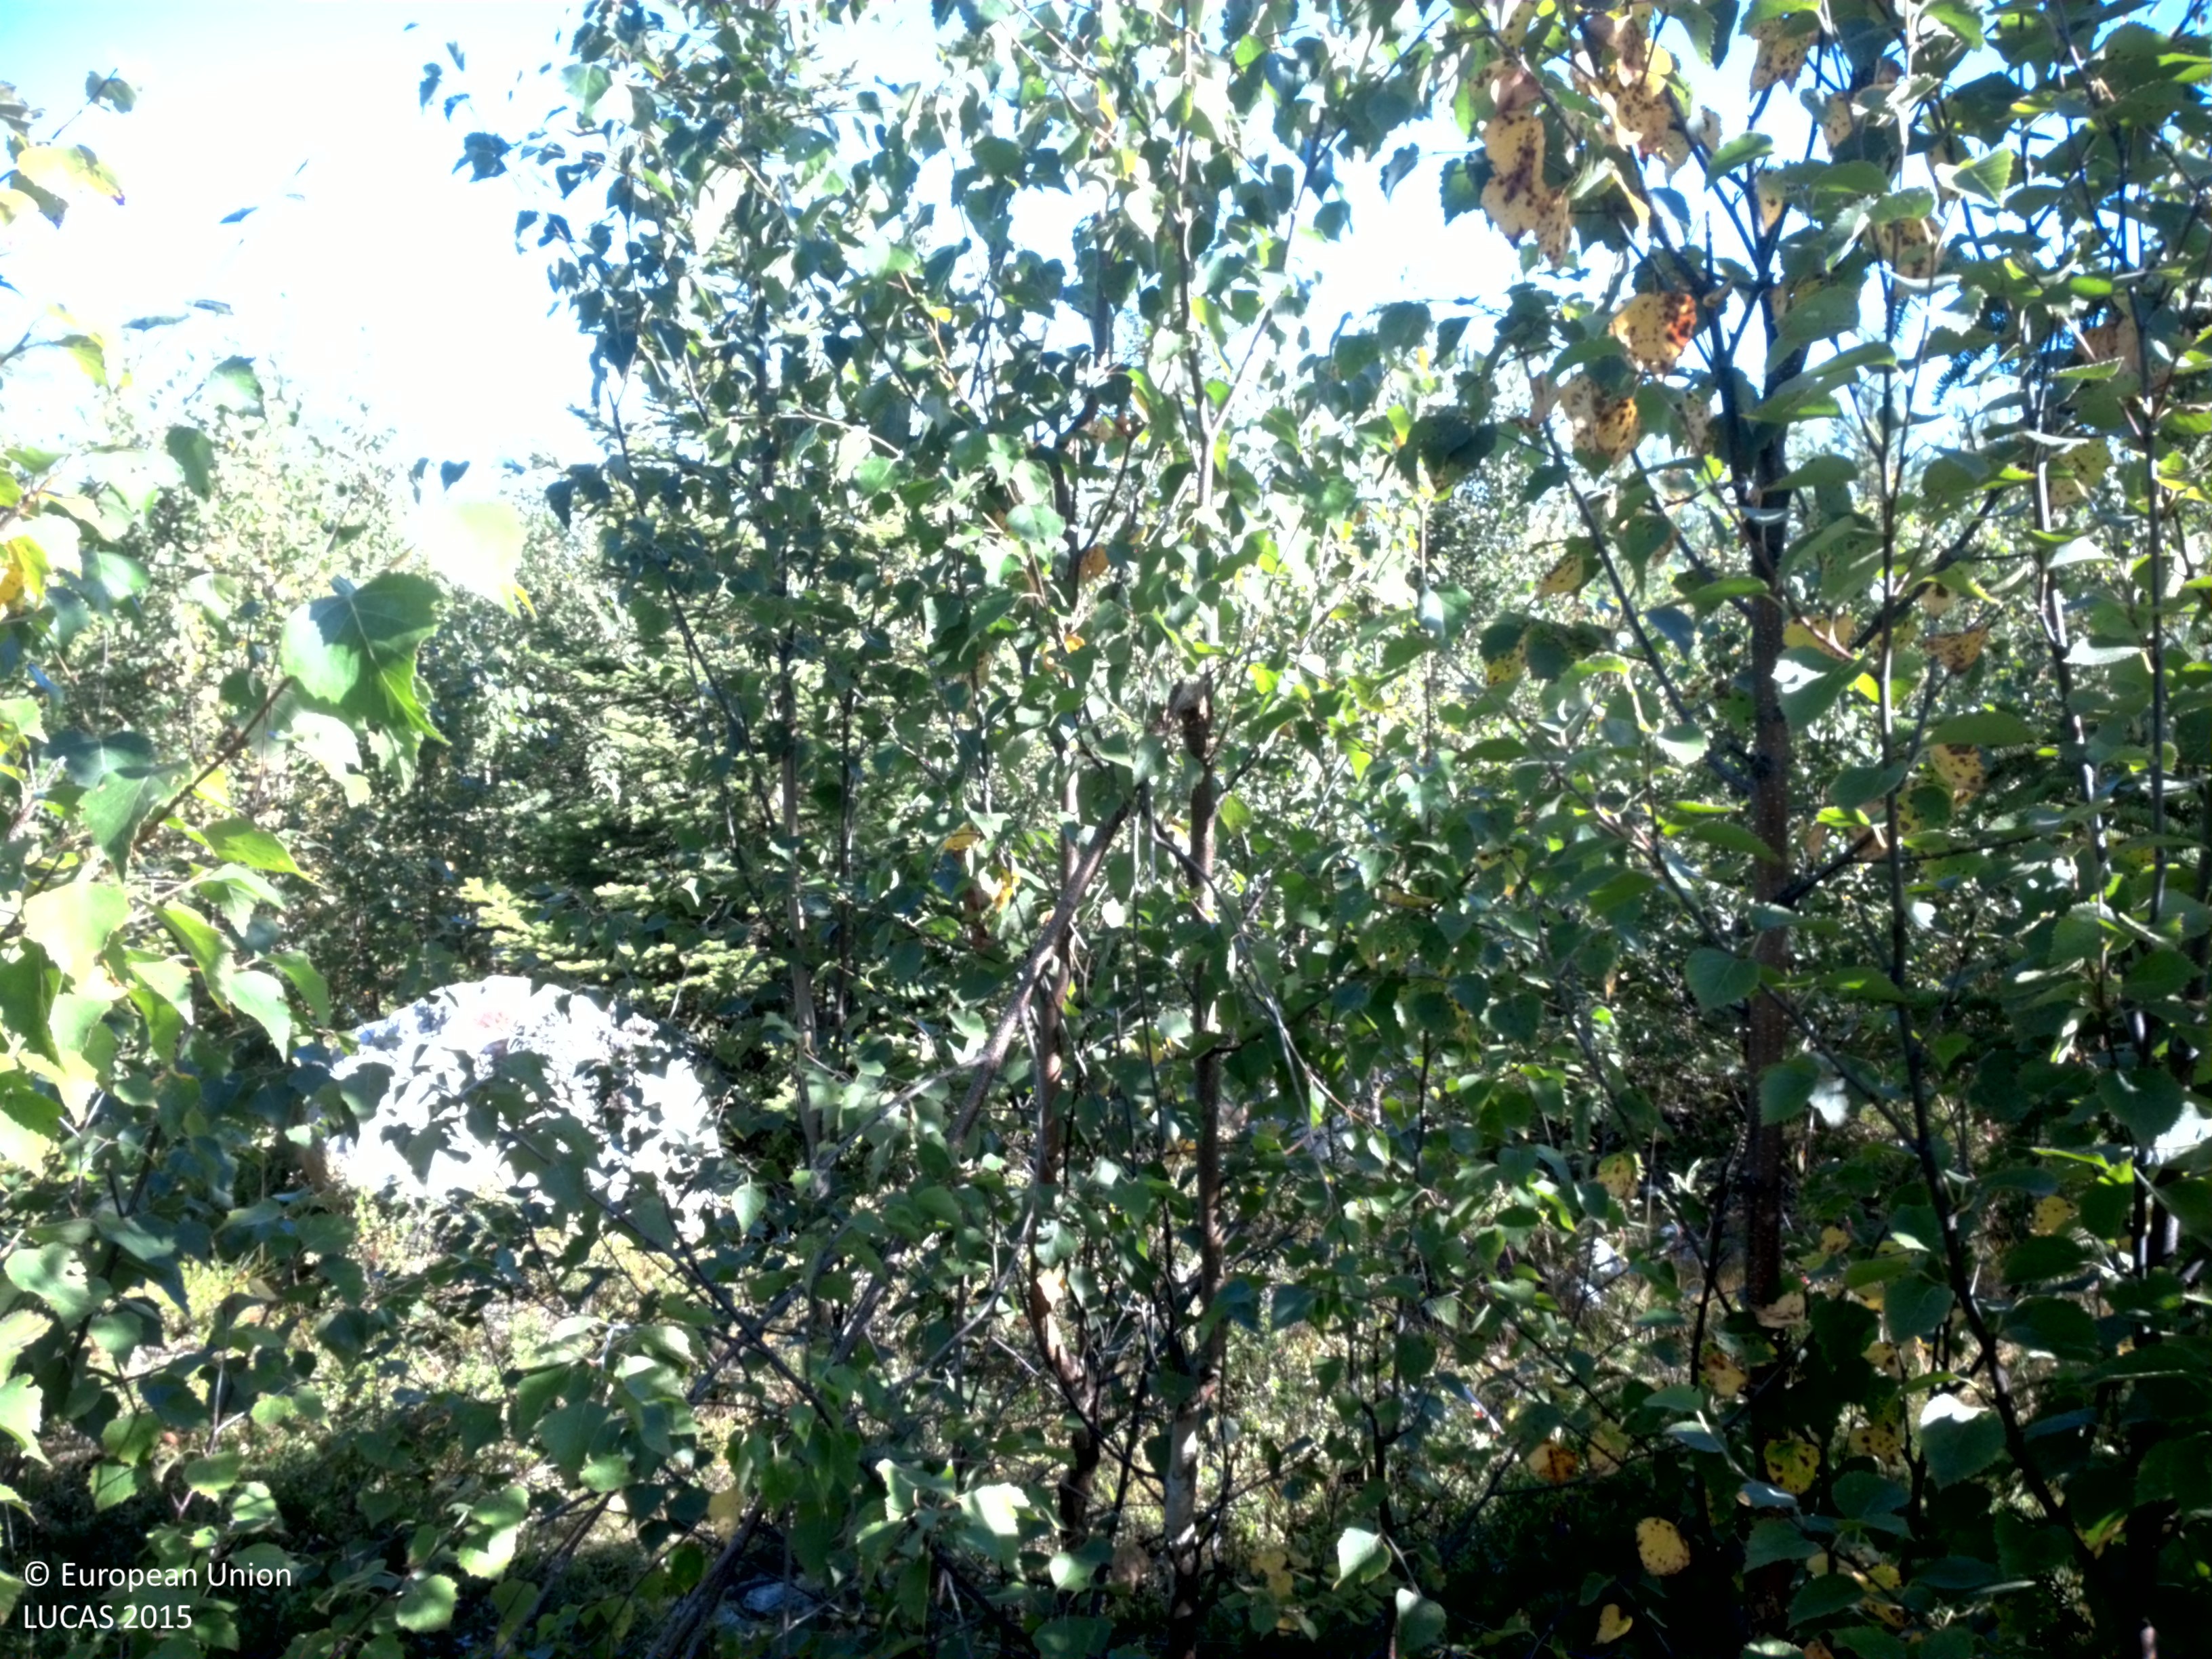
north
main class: Woodland
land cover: Broadleaved woodland
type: boreal forest
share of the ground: > 75 %
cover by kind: broadleaved forest trees 75 %, coniferous forest trees 10 %, shrubs 10 %, herbaceous plants 5 %
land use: Forestry
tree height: < 5 m
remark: Clear cut
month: August
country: SE
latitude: 64.5005
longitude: 20.5745
